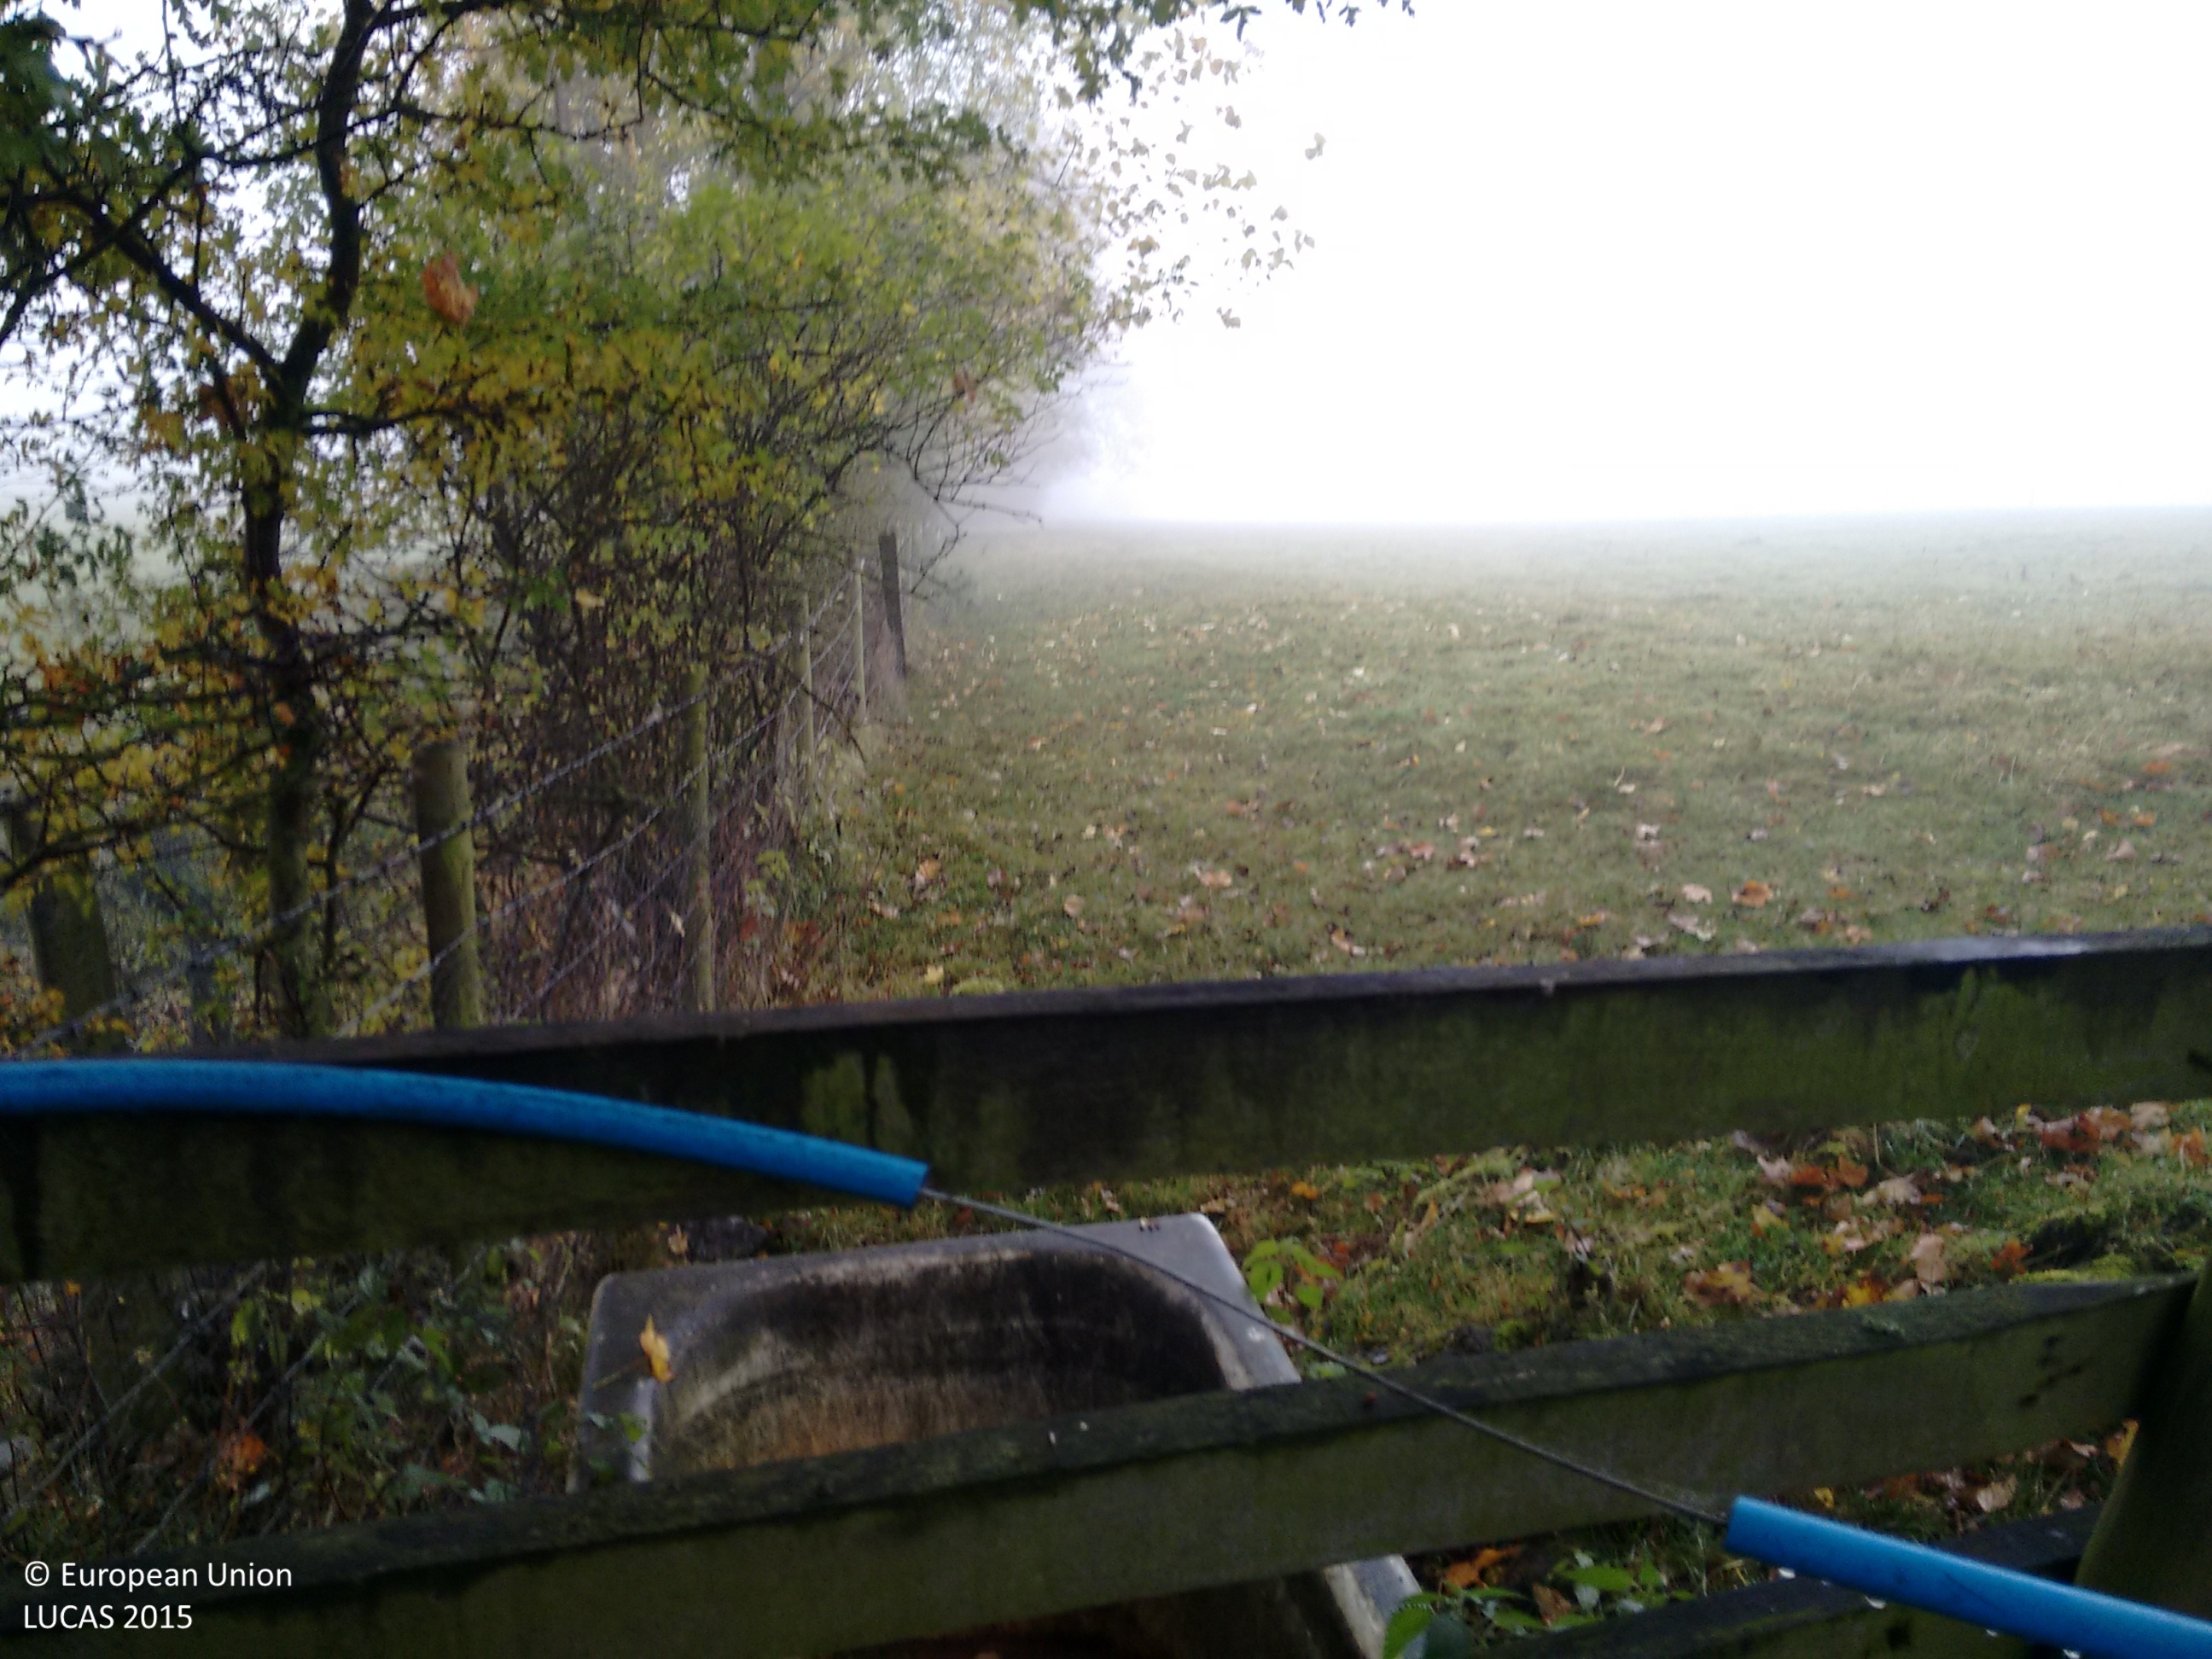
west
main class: Grassland
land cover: Grassland without tree/shrub cover
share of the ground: > 75 %
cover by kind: herbaceous plants 100 %
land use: Agriculture (excluding fallow land and kitchen gardens)
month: October
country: GB
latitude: 54.5187
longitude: -1.9346
